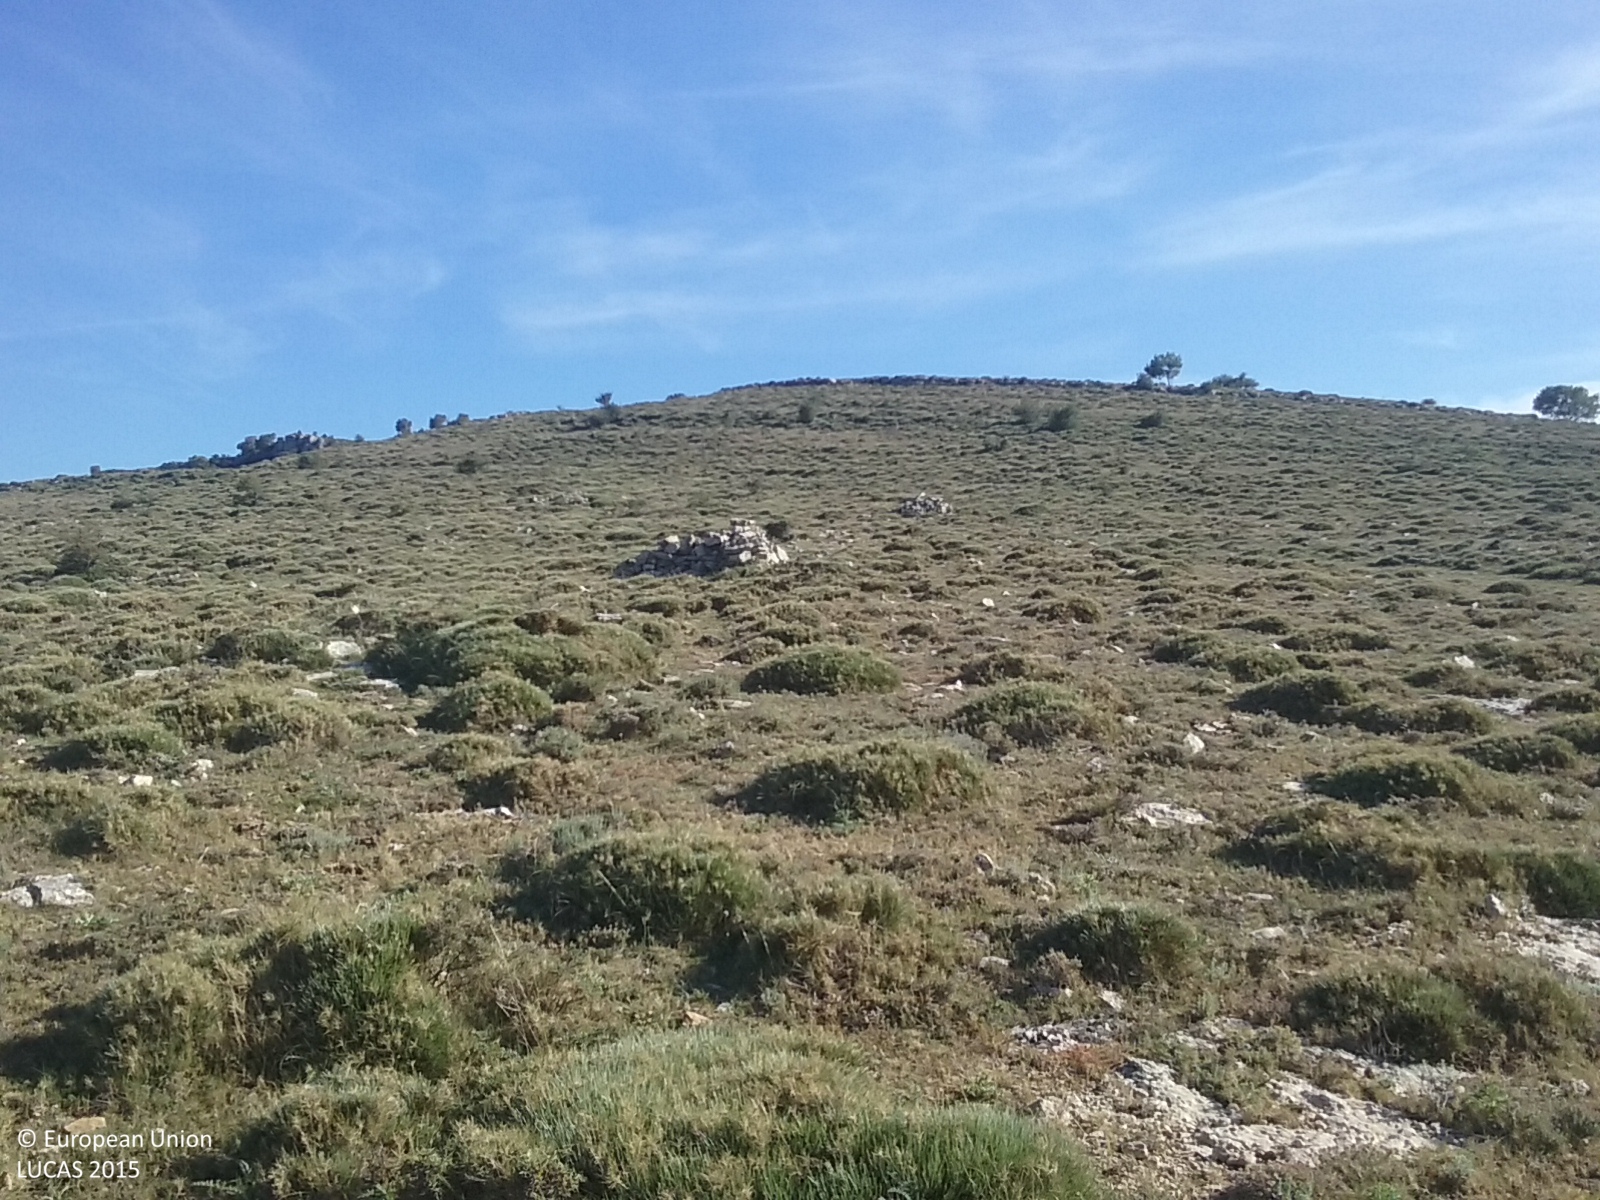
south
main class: Shrubland
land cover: Shrubland without tree cover
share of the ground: > 75 %
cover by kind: herbaceous plants 60 %, shrubs 30 %
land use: Agriculture (excluding fallow land and kitchen gardens)
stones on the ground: 25 - 50 %
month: May
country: ES
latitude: 40.4231
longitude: -0.0590
